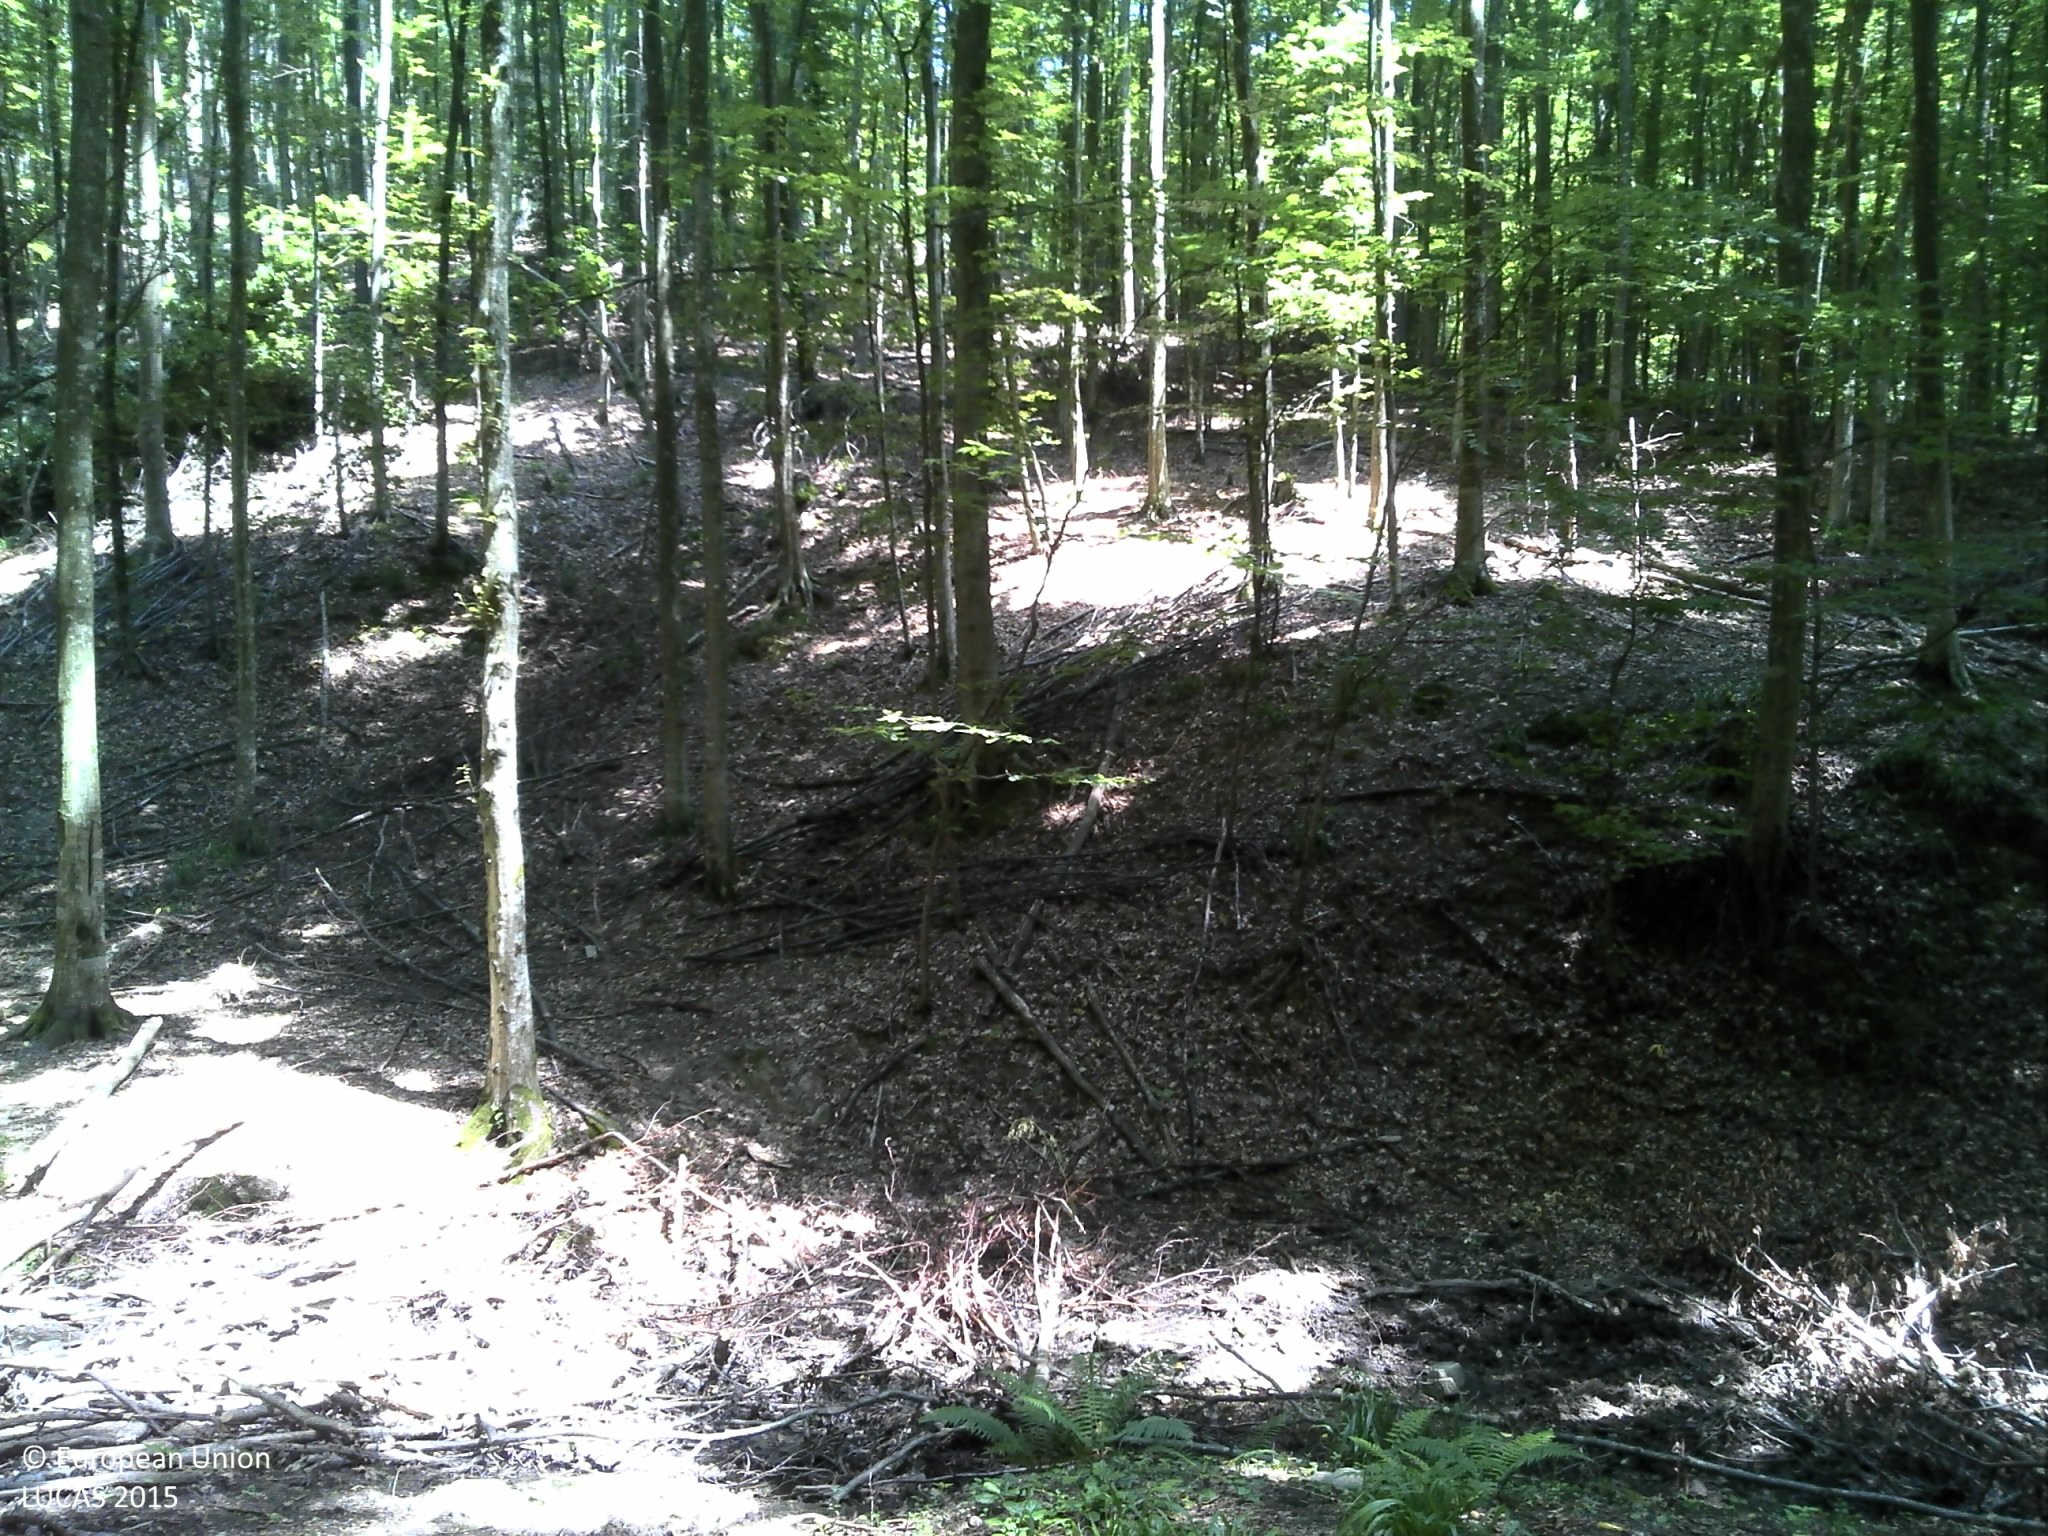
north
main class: Woodland
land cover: Broadleaved woodland
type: acidophilous oak and oak-birch forest
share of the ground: > 75 %
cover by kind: broadleaved forest trees 90 %, shrubs 5 %, herbaceous plants 5 %
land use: Forestry
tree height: > 5 m
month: July
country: HR
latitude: 45.6915
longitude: 16.6639
